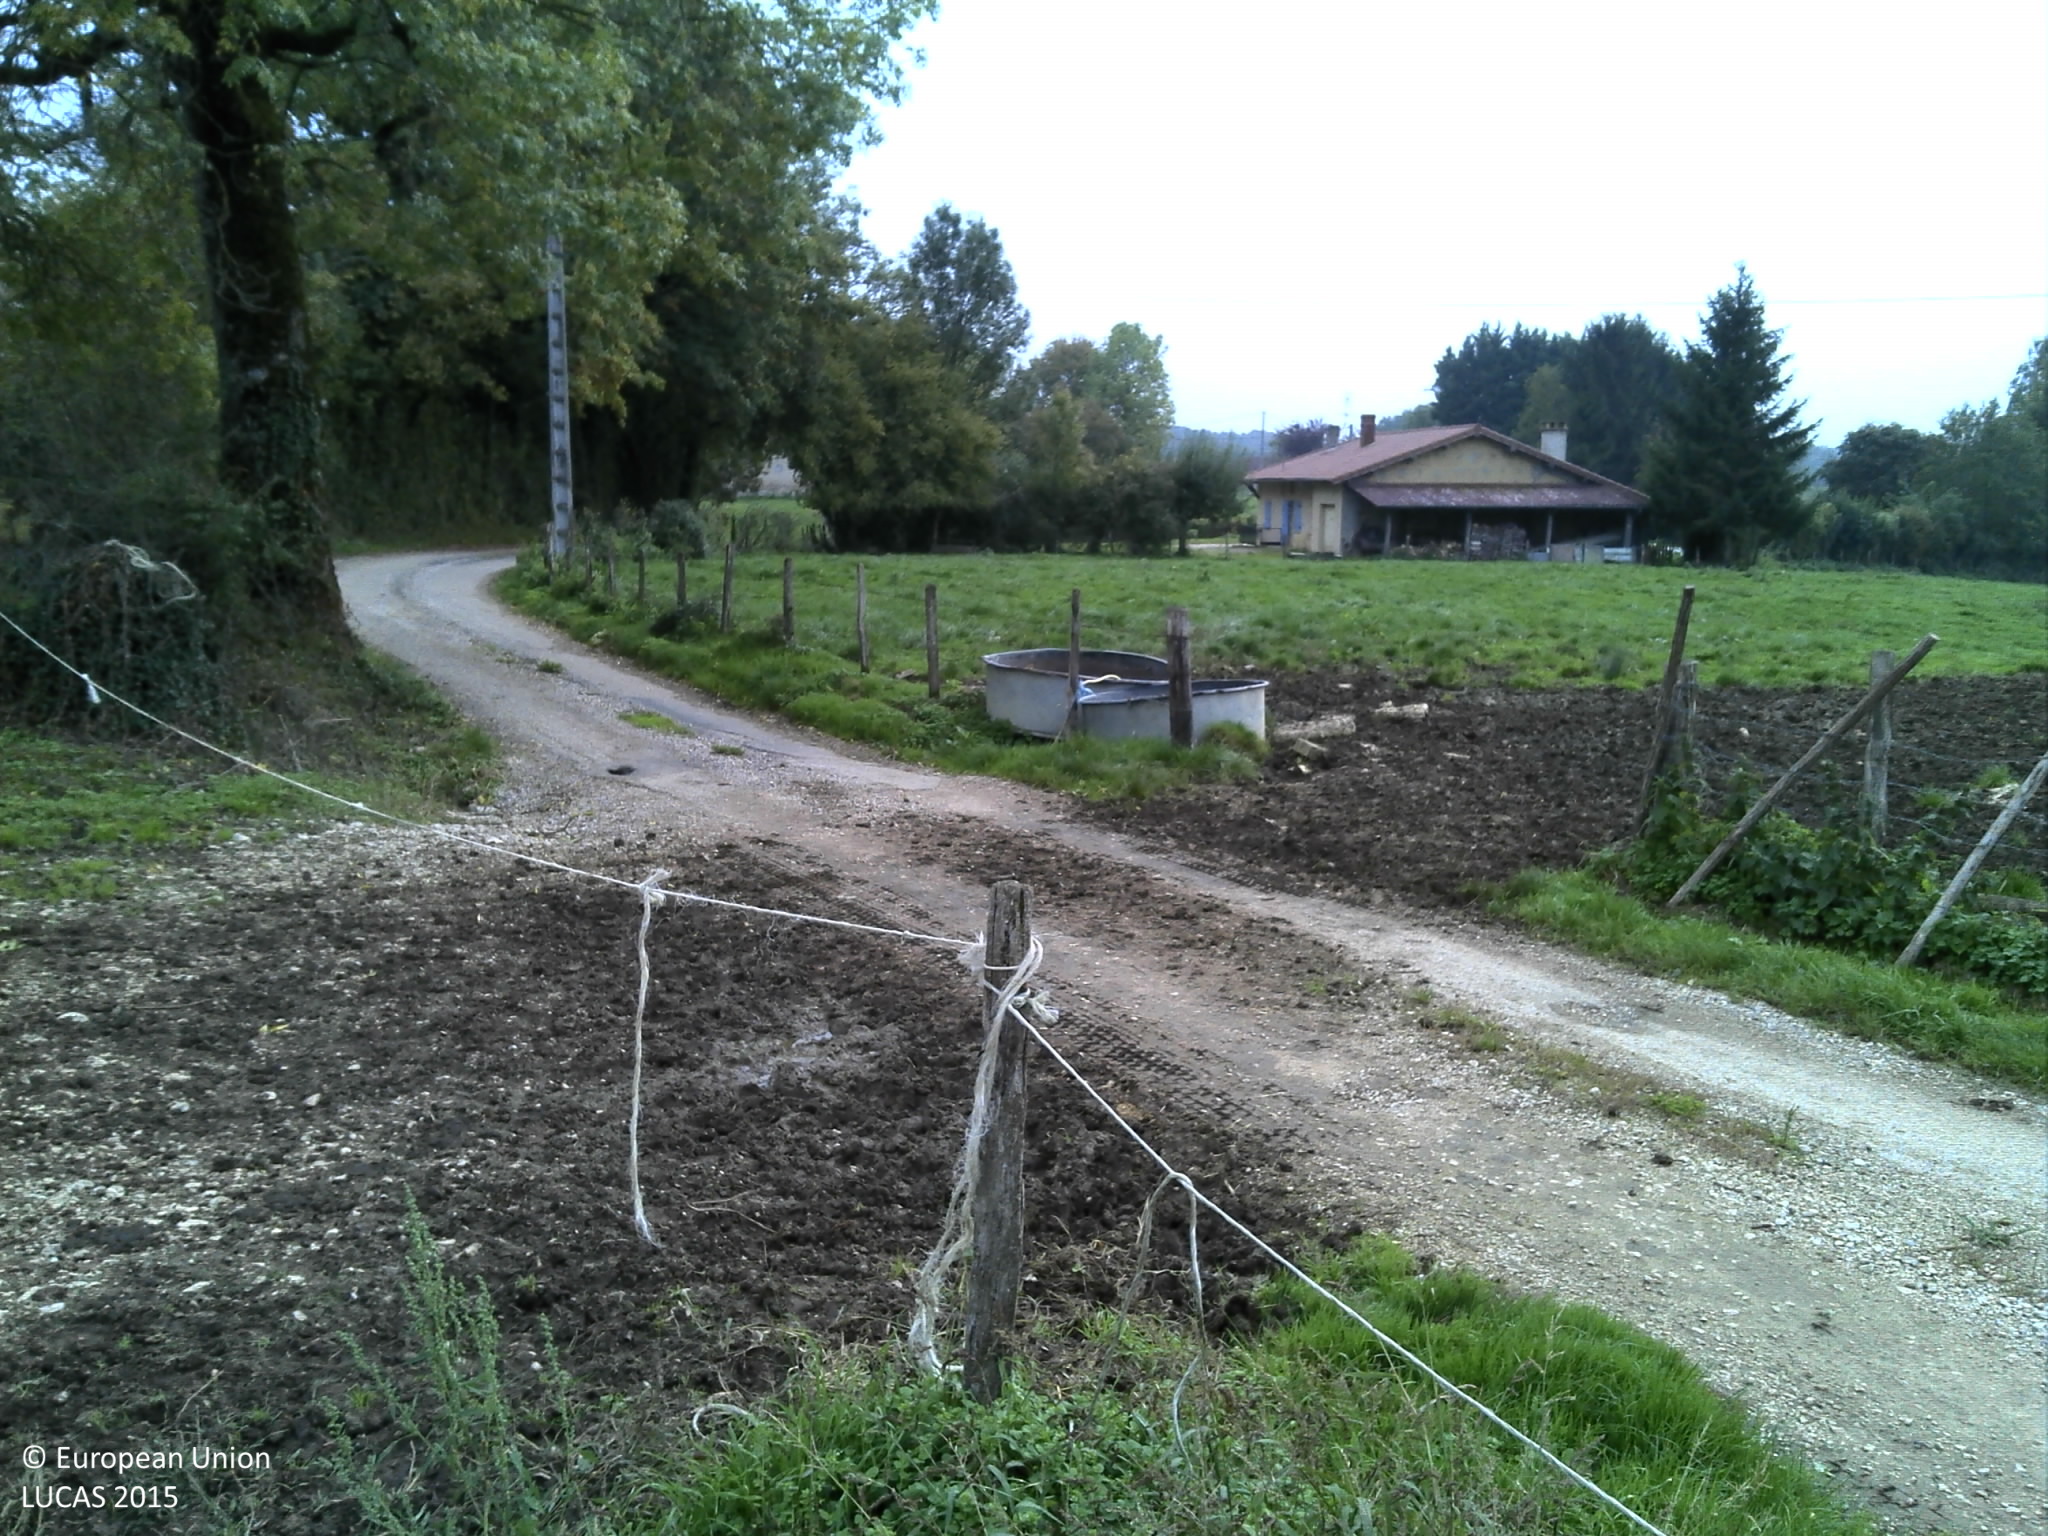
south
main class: Grassland
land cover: Spontaneously vegetated surfaces
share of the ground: > 75 %
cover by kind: herbaceous plants 100 %
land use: Semi-natural and natural areas not in use
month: October
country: FR
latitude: 46.3028
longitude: 5.3158
